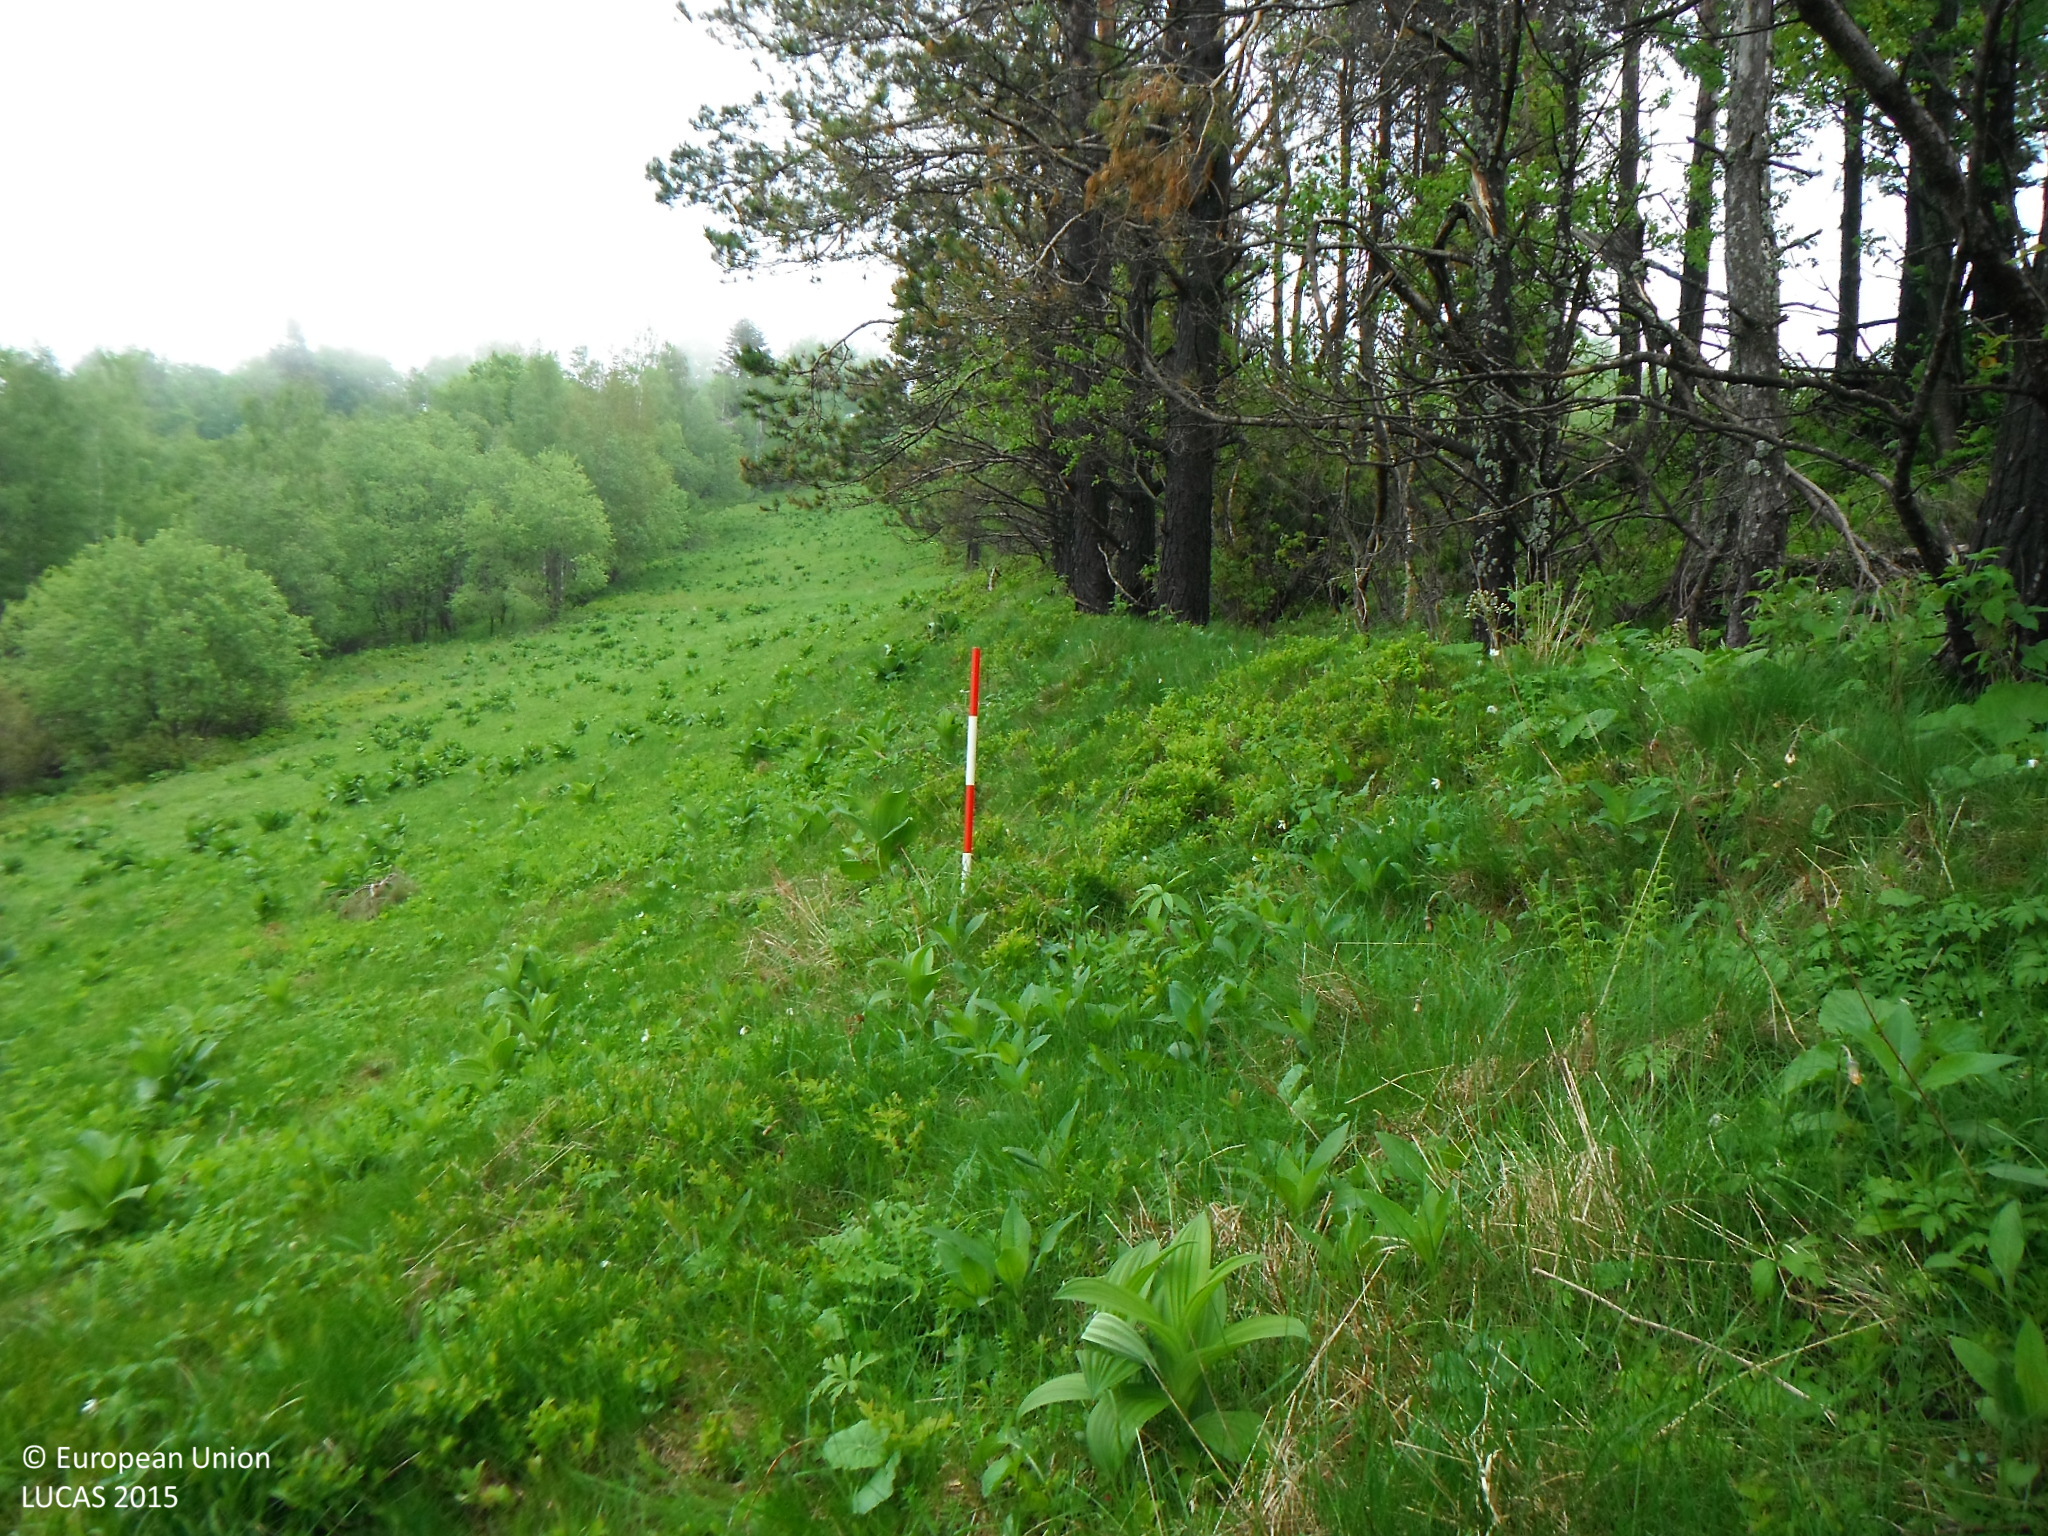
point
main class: Grassland
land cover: Spontaneously vegetated surfaces
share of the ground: > 75 %
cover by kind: herbaceous plants 100 %
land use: Sport
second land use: Amenities, museums, leisure
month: May
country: SK
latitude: 49.1645
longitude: 21.1388
